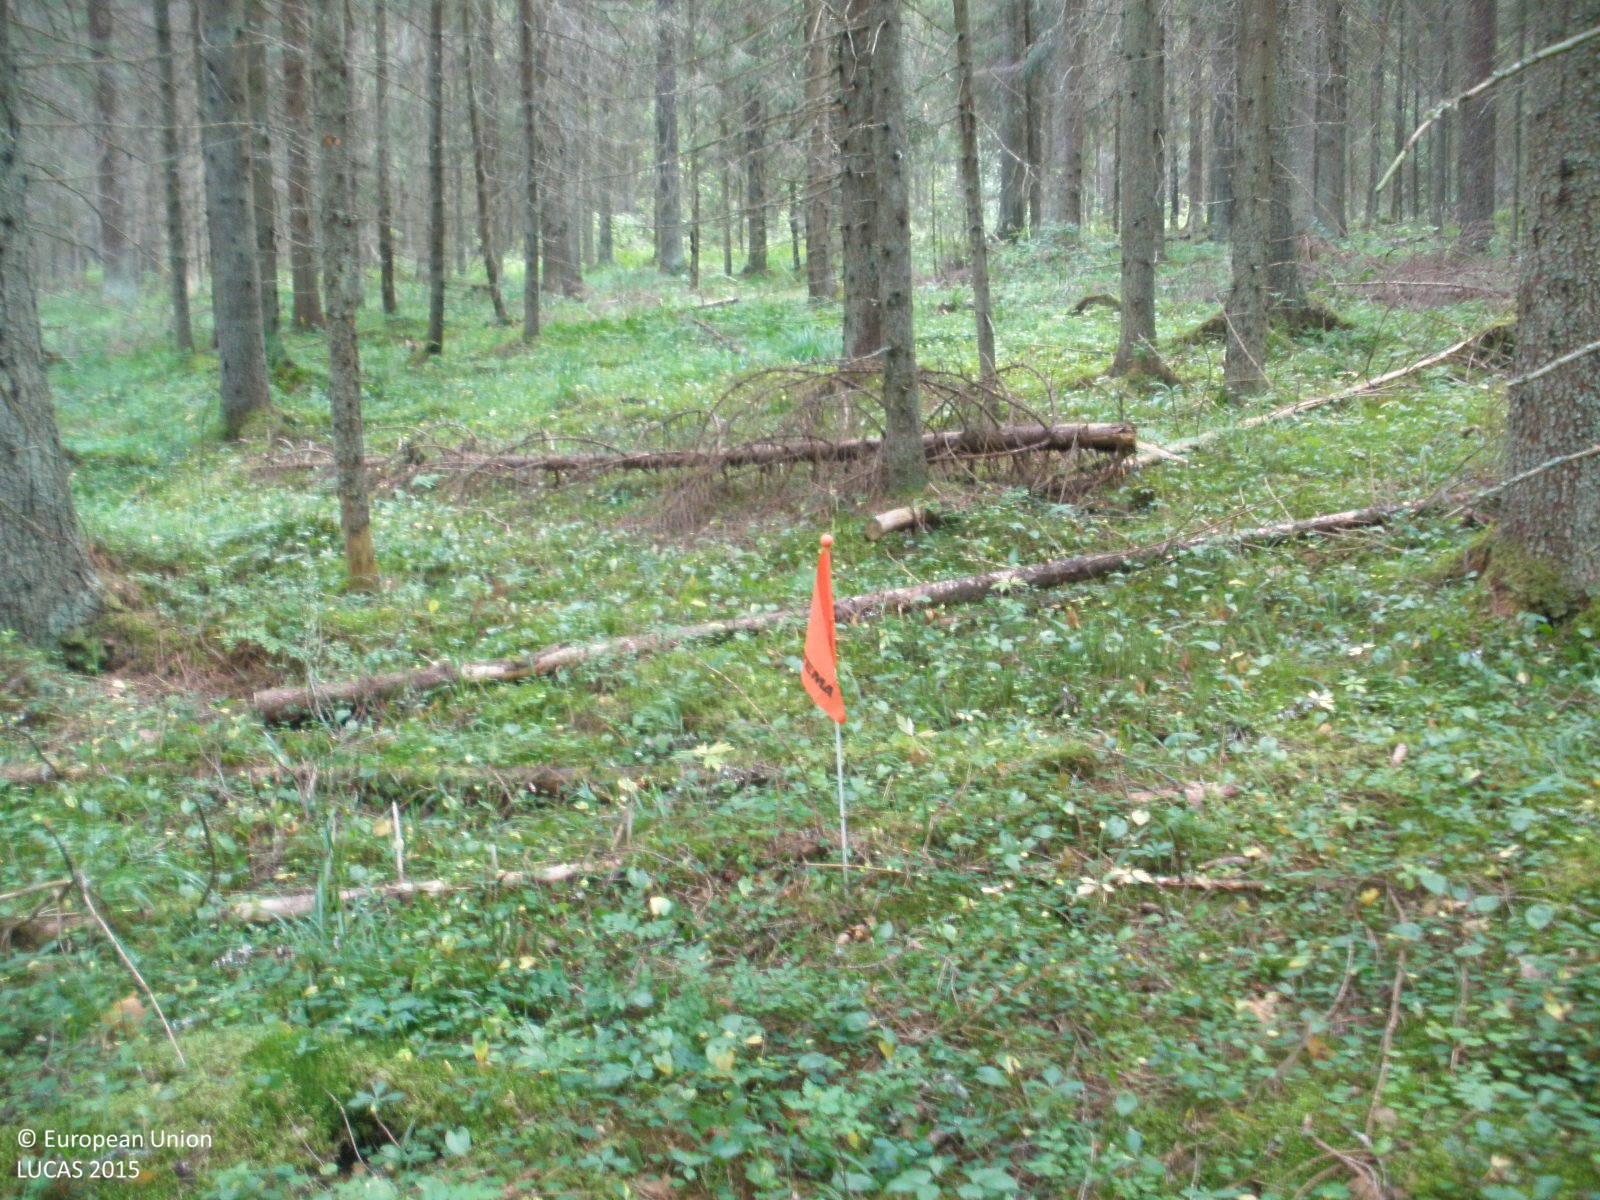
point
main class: Woodland
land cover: Spruce dominated coniferous woodland
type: boreal forest
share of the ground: > 75 %
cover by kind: coniferous forest trees 90 %, herbaceous plants 5 %, lichens and mosses 5 %
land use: Forestry
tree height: > 5 m
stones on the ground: < 10 %
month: August
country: FI
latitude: 60.9802
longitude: 24.9137
